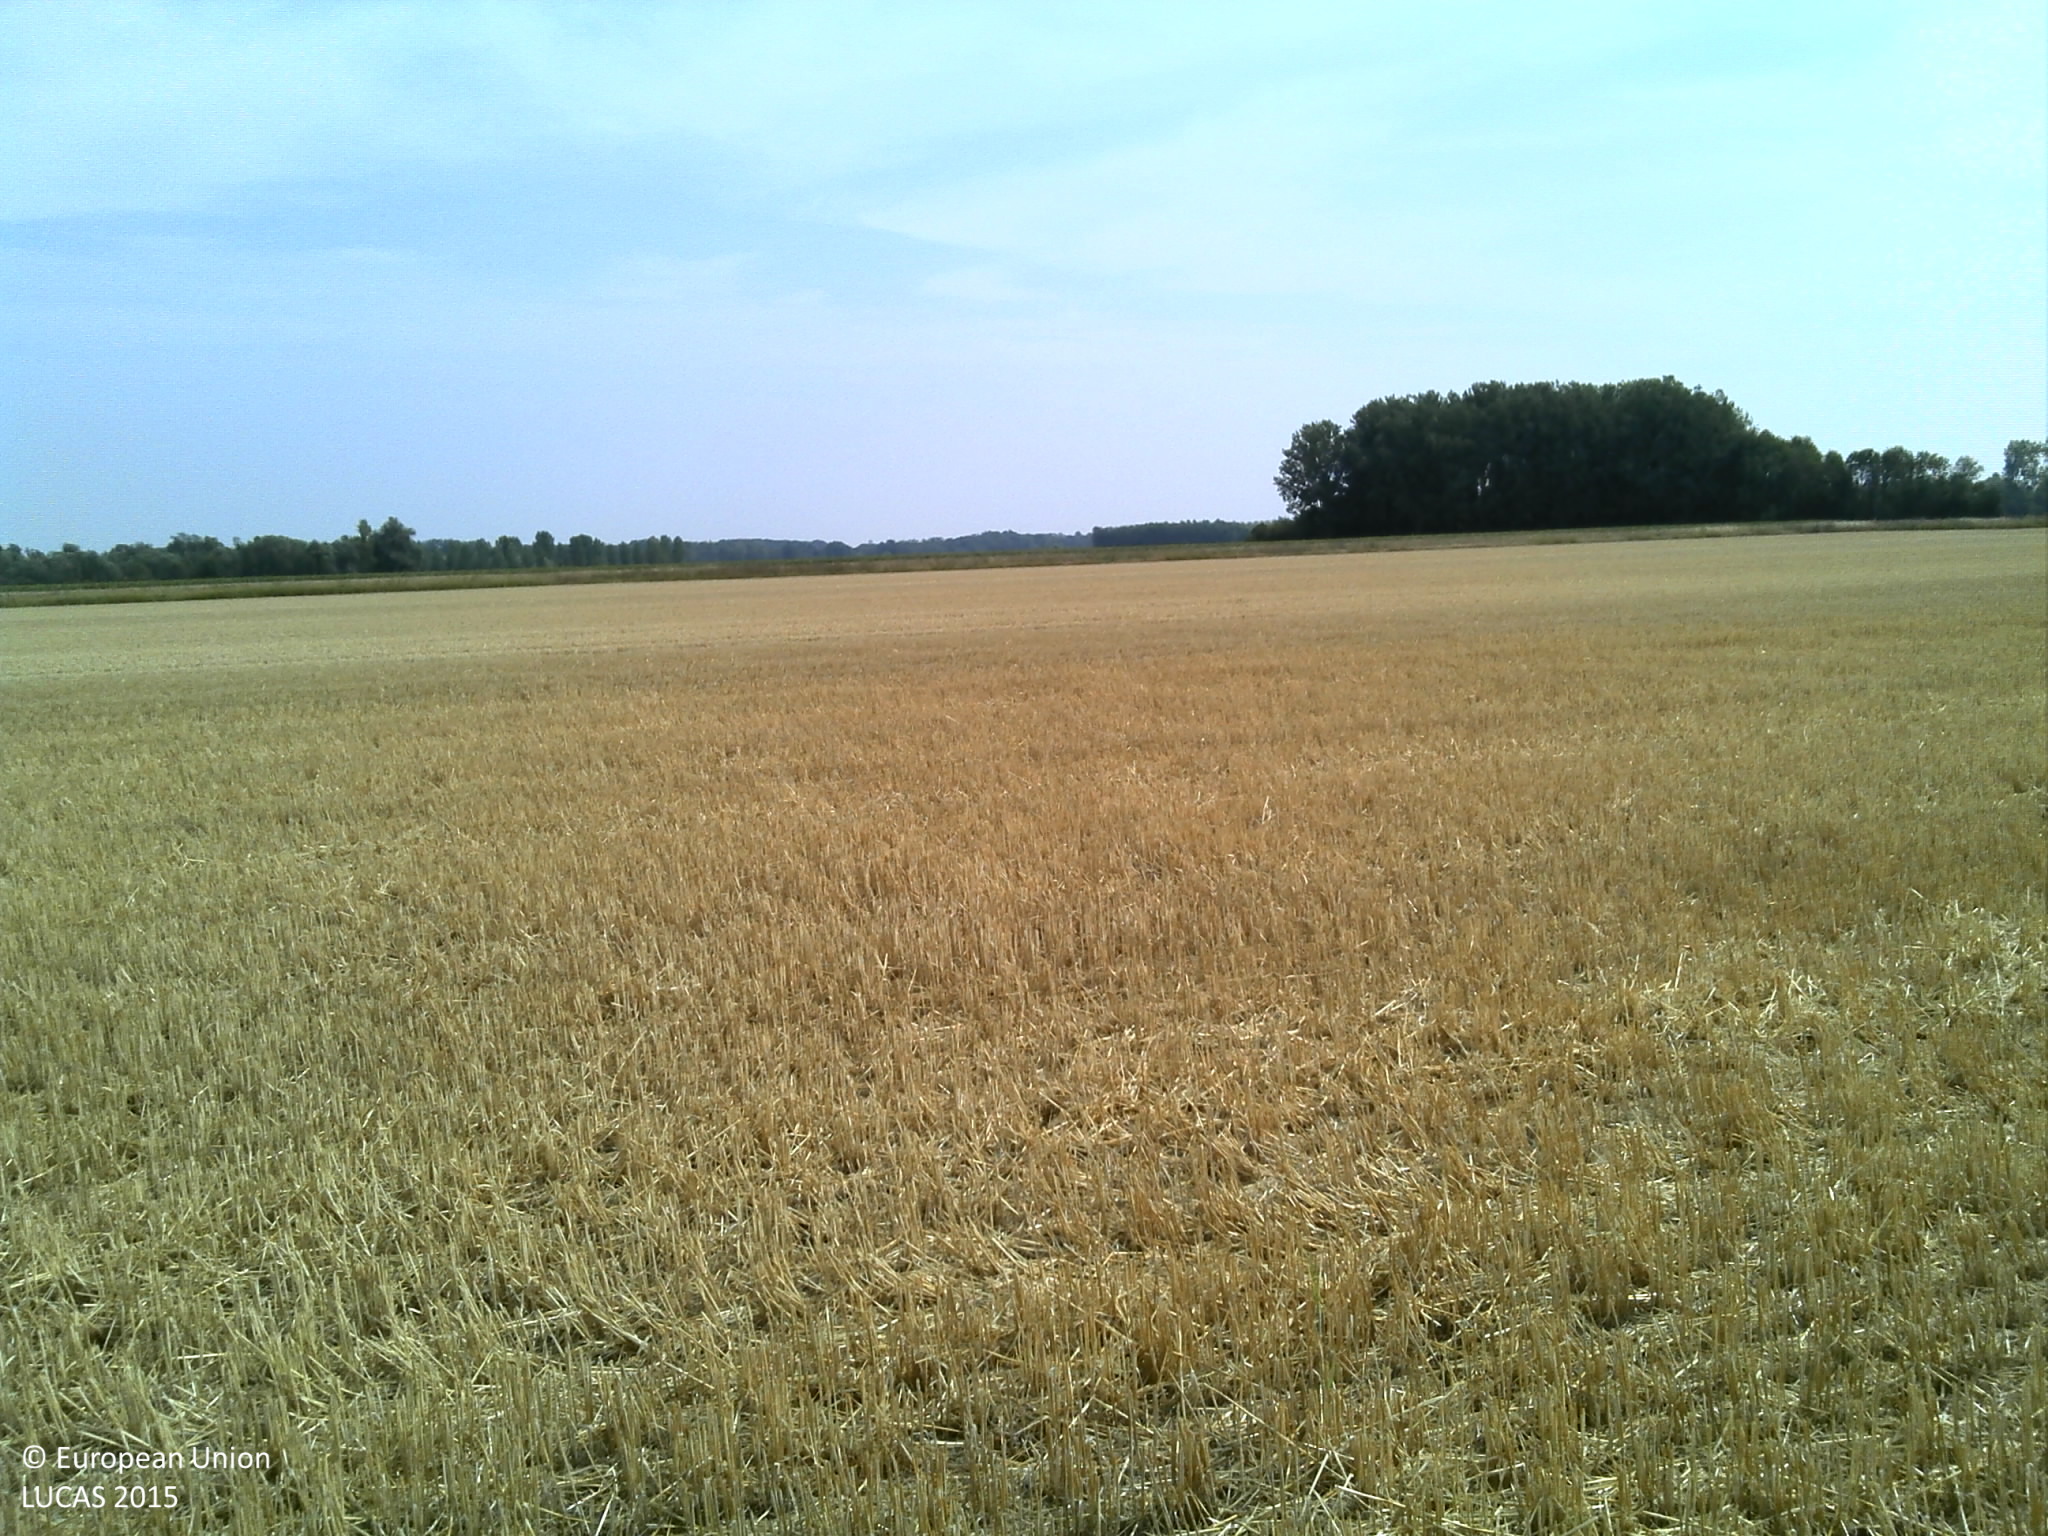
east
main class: Cropland
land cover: Barley
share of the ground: > 75 %
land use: Agriculture (excluding fallow land and kitchen gardens)
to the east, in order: Barley; Spontaneously vegetated surfaces
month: August
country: FR
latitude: 49.0095
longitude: 4.2128
